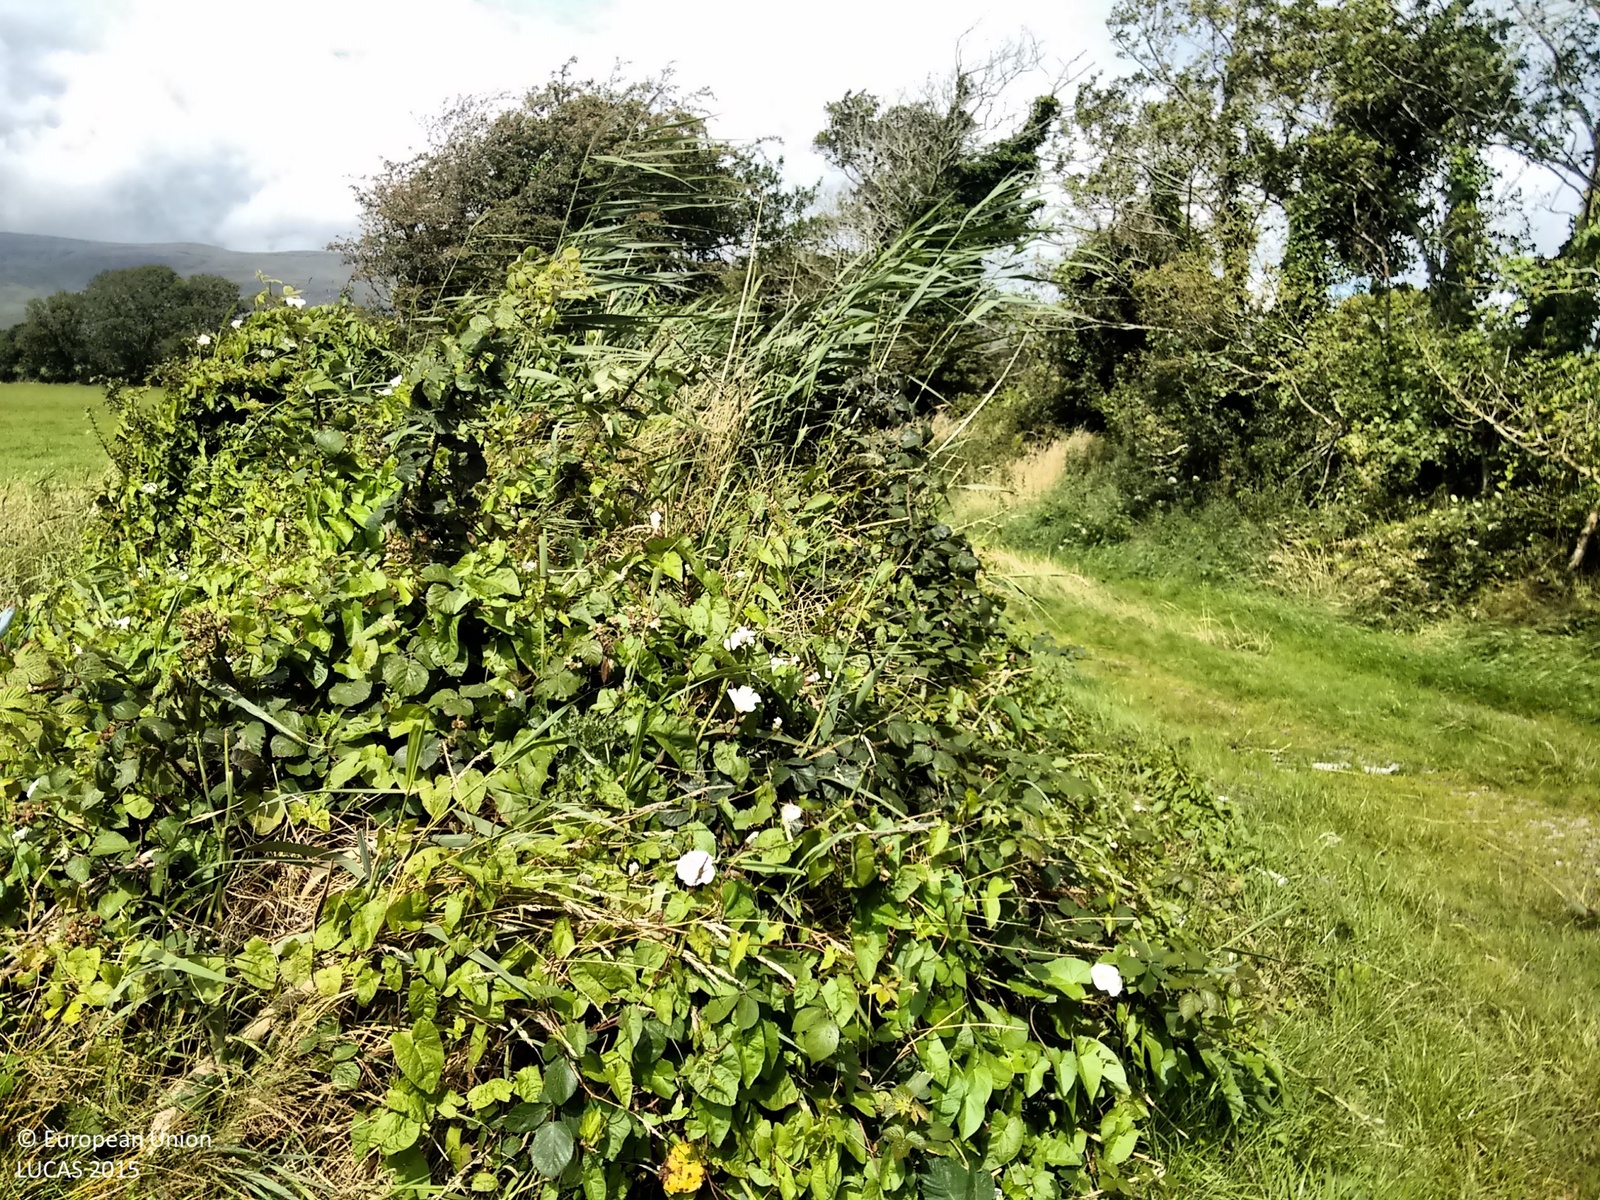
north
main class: Grassland
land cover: Grassland without tree/shrub cover
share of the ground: > 75 %
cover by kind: herbaceous plants 100 %
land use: Agriculture (excluding fallow land and kitchen gardens)
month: August
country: IE
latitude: 52.1616
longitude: -9.7292
